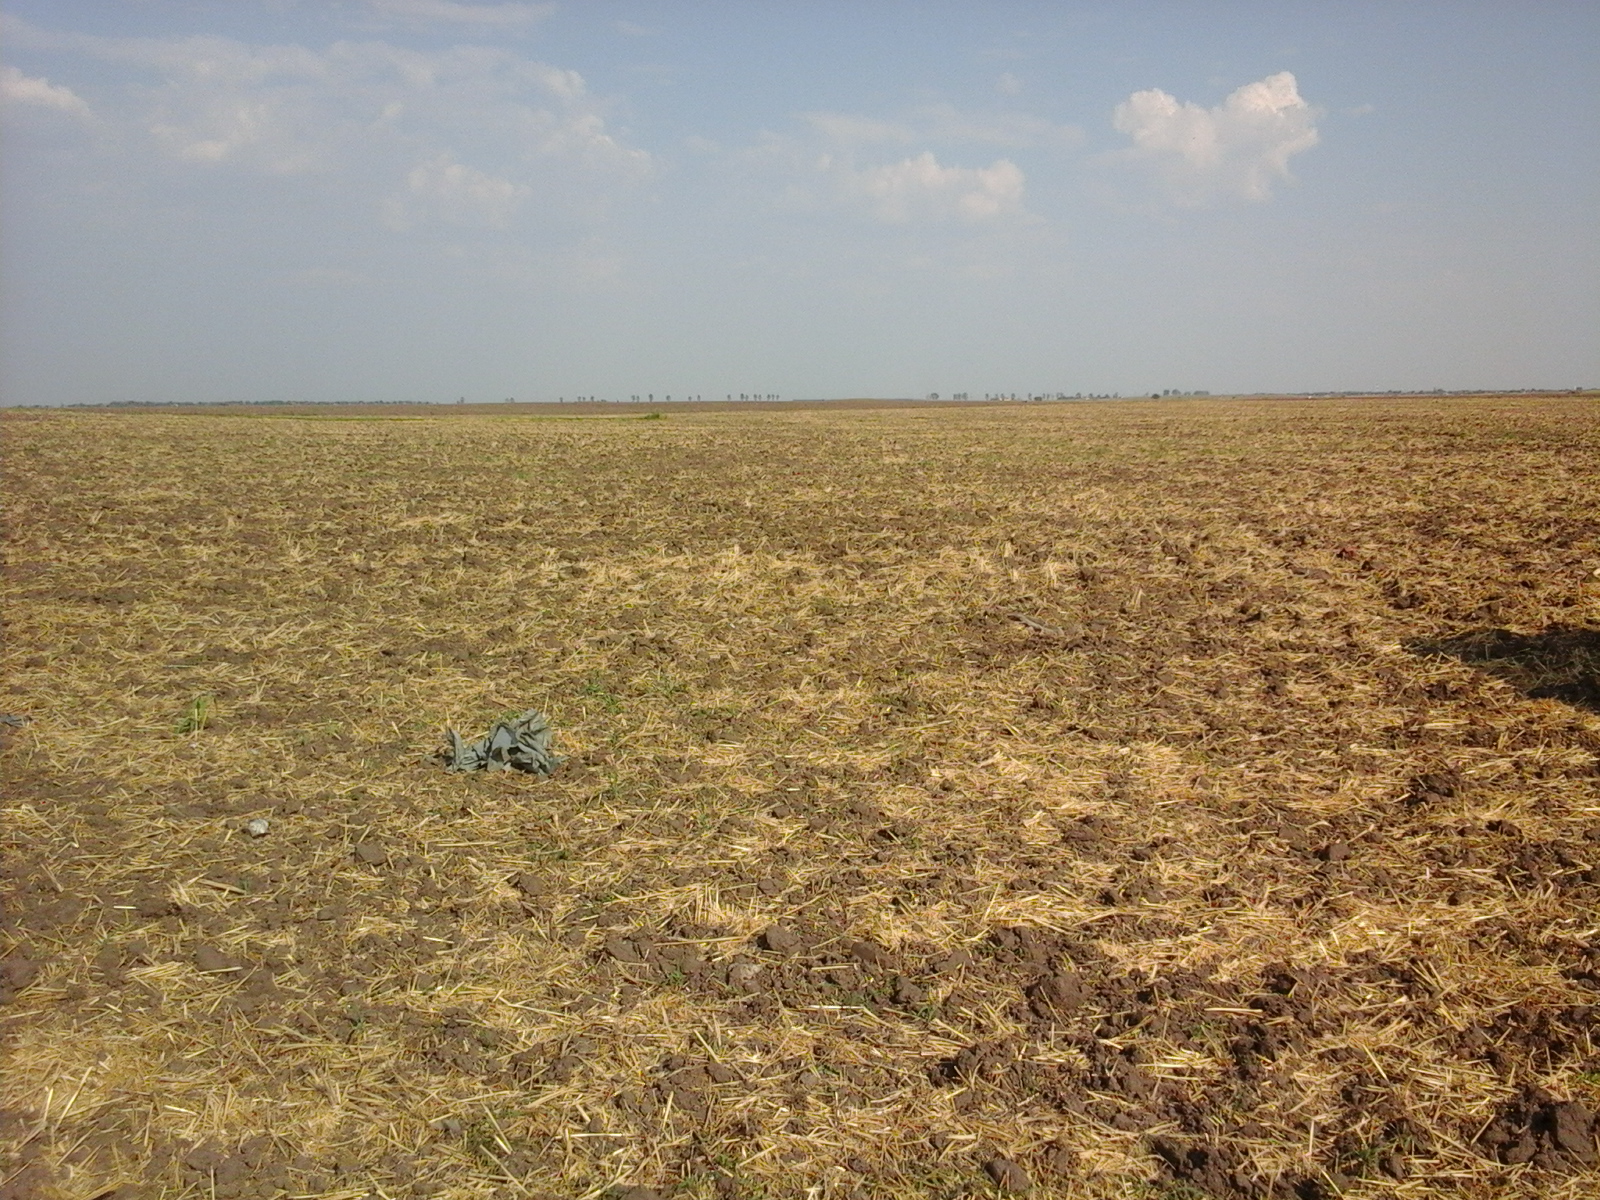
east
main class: Cropland
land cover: Common wheat
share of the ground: 10 - 25 %
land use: Agriculture (excluding fallow land and kitchen gardens)
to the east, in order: Common wheat
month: August
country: RO
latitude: 43.9124
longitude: 23.5603
